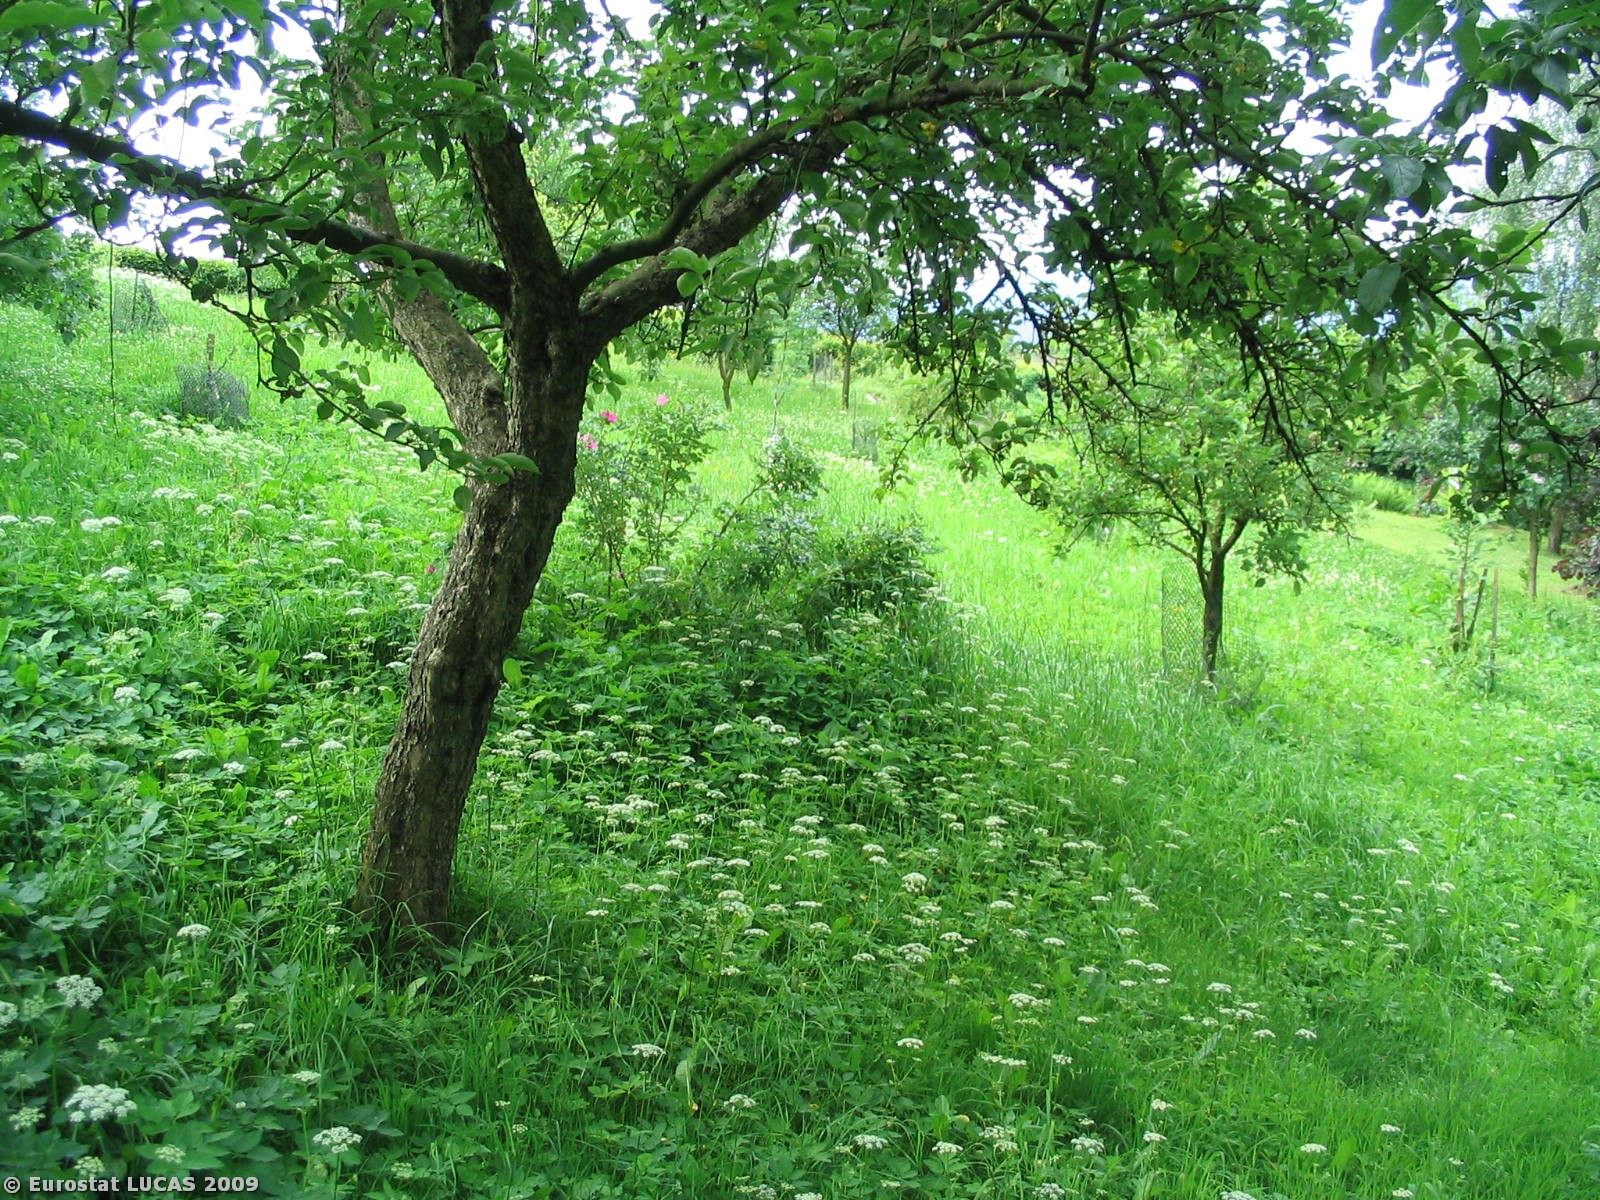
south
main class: Cropland
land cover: Apple fruit
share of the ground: 50 - 75 %
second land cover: Grassland with sparse tree/shrub cover
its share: > 75 %
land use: Kitchen garden
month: June
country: CZ
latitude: 49.5762
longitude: 18.7468
